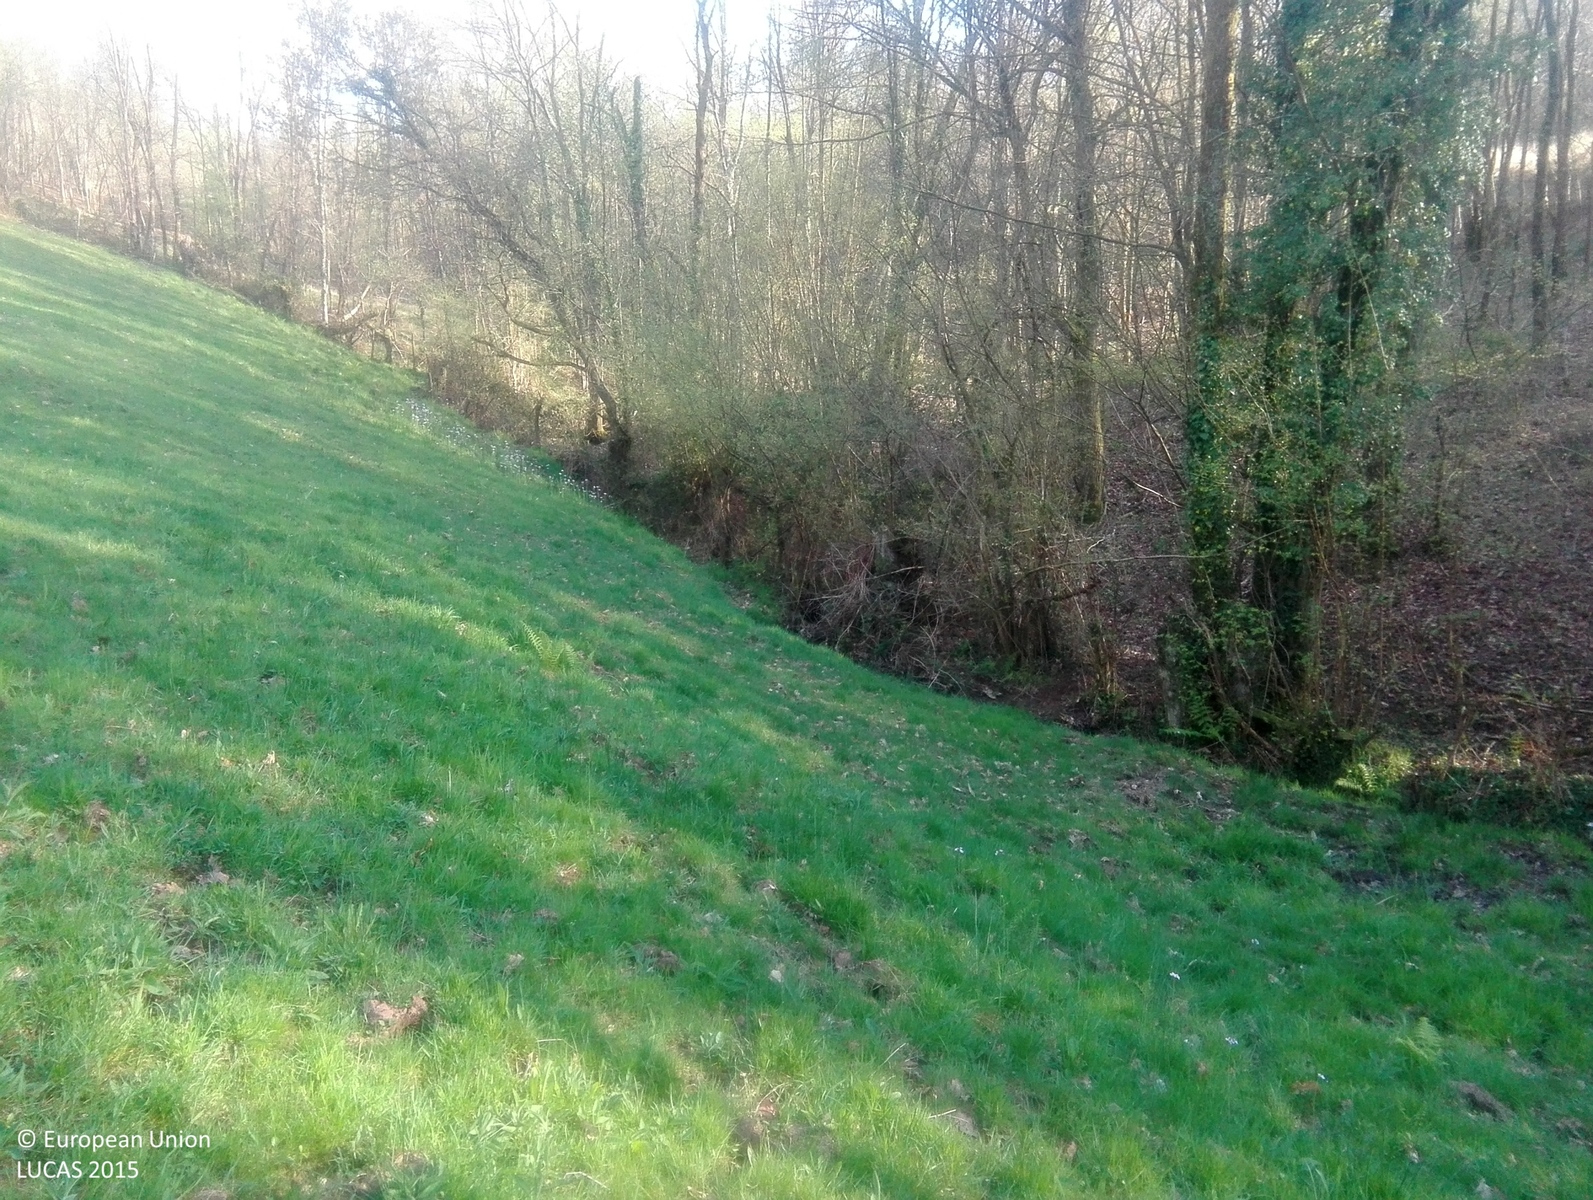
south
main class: Grassland
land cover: Grassland without tree/shrub cover
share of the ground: > 75 %
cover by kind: herbaceous plants 100 %
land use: Agriculture (excluding fallow land and kitchen gardens)
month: April
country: ES
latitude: 43.3787
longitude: -5.6225
